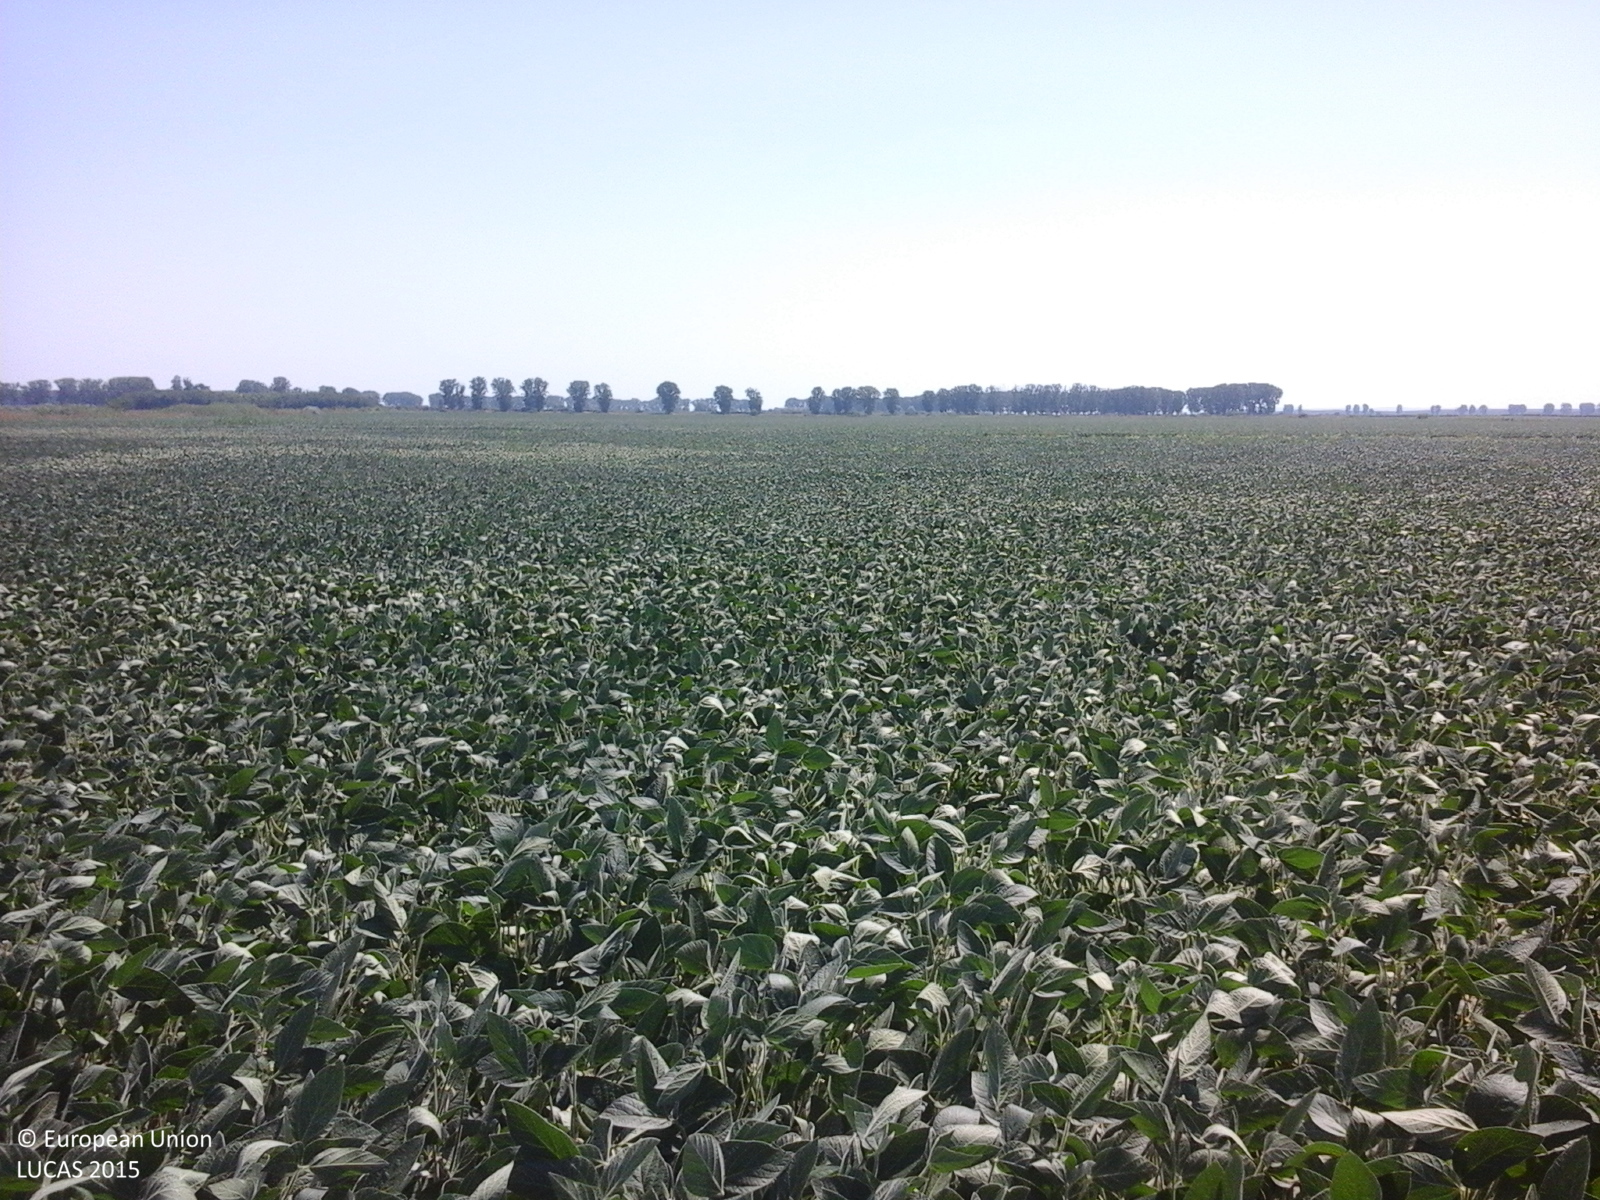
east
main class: Cropland
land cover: Soya
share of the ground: > 75 %
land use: Agriculture (excluding fallow land and kitchen gardens)
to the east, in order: Soya
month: July
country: RO
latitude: 44.1822
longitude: 27.0260
